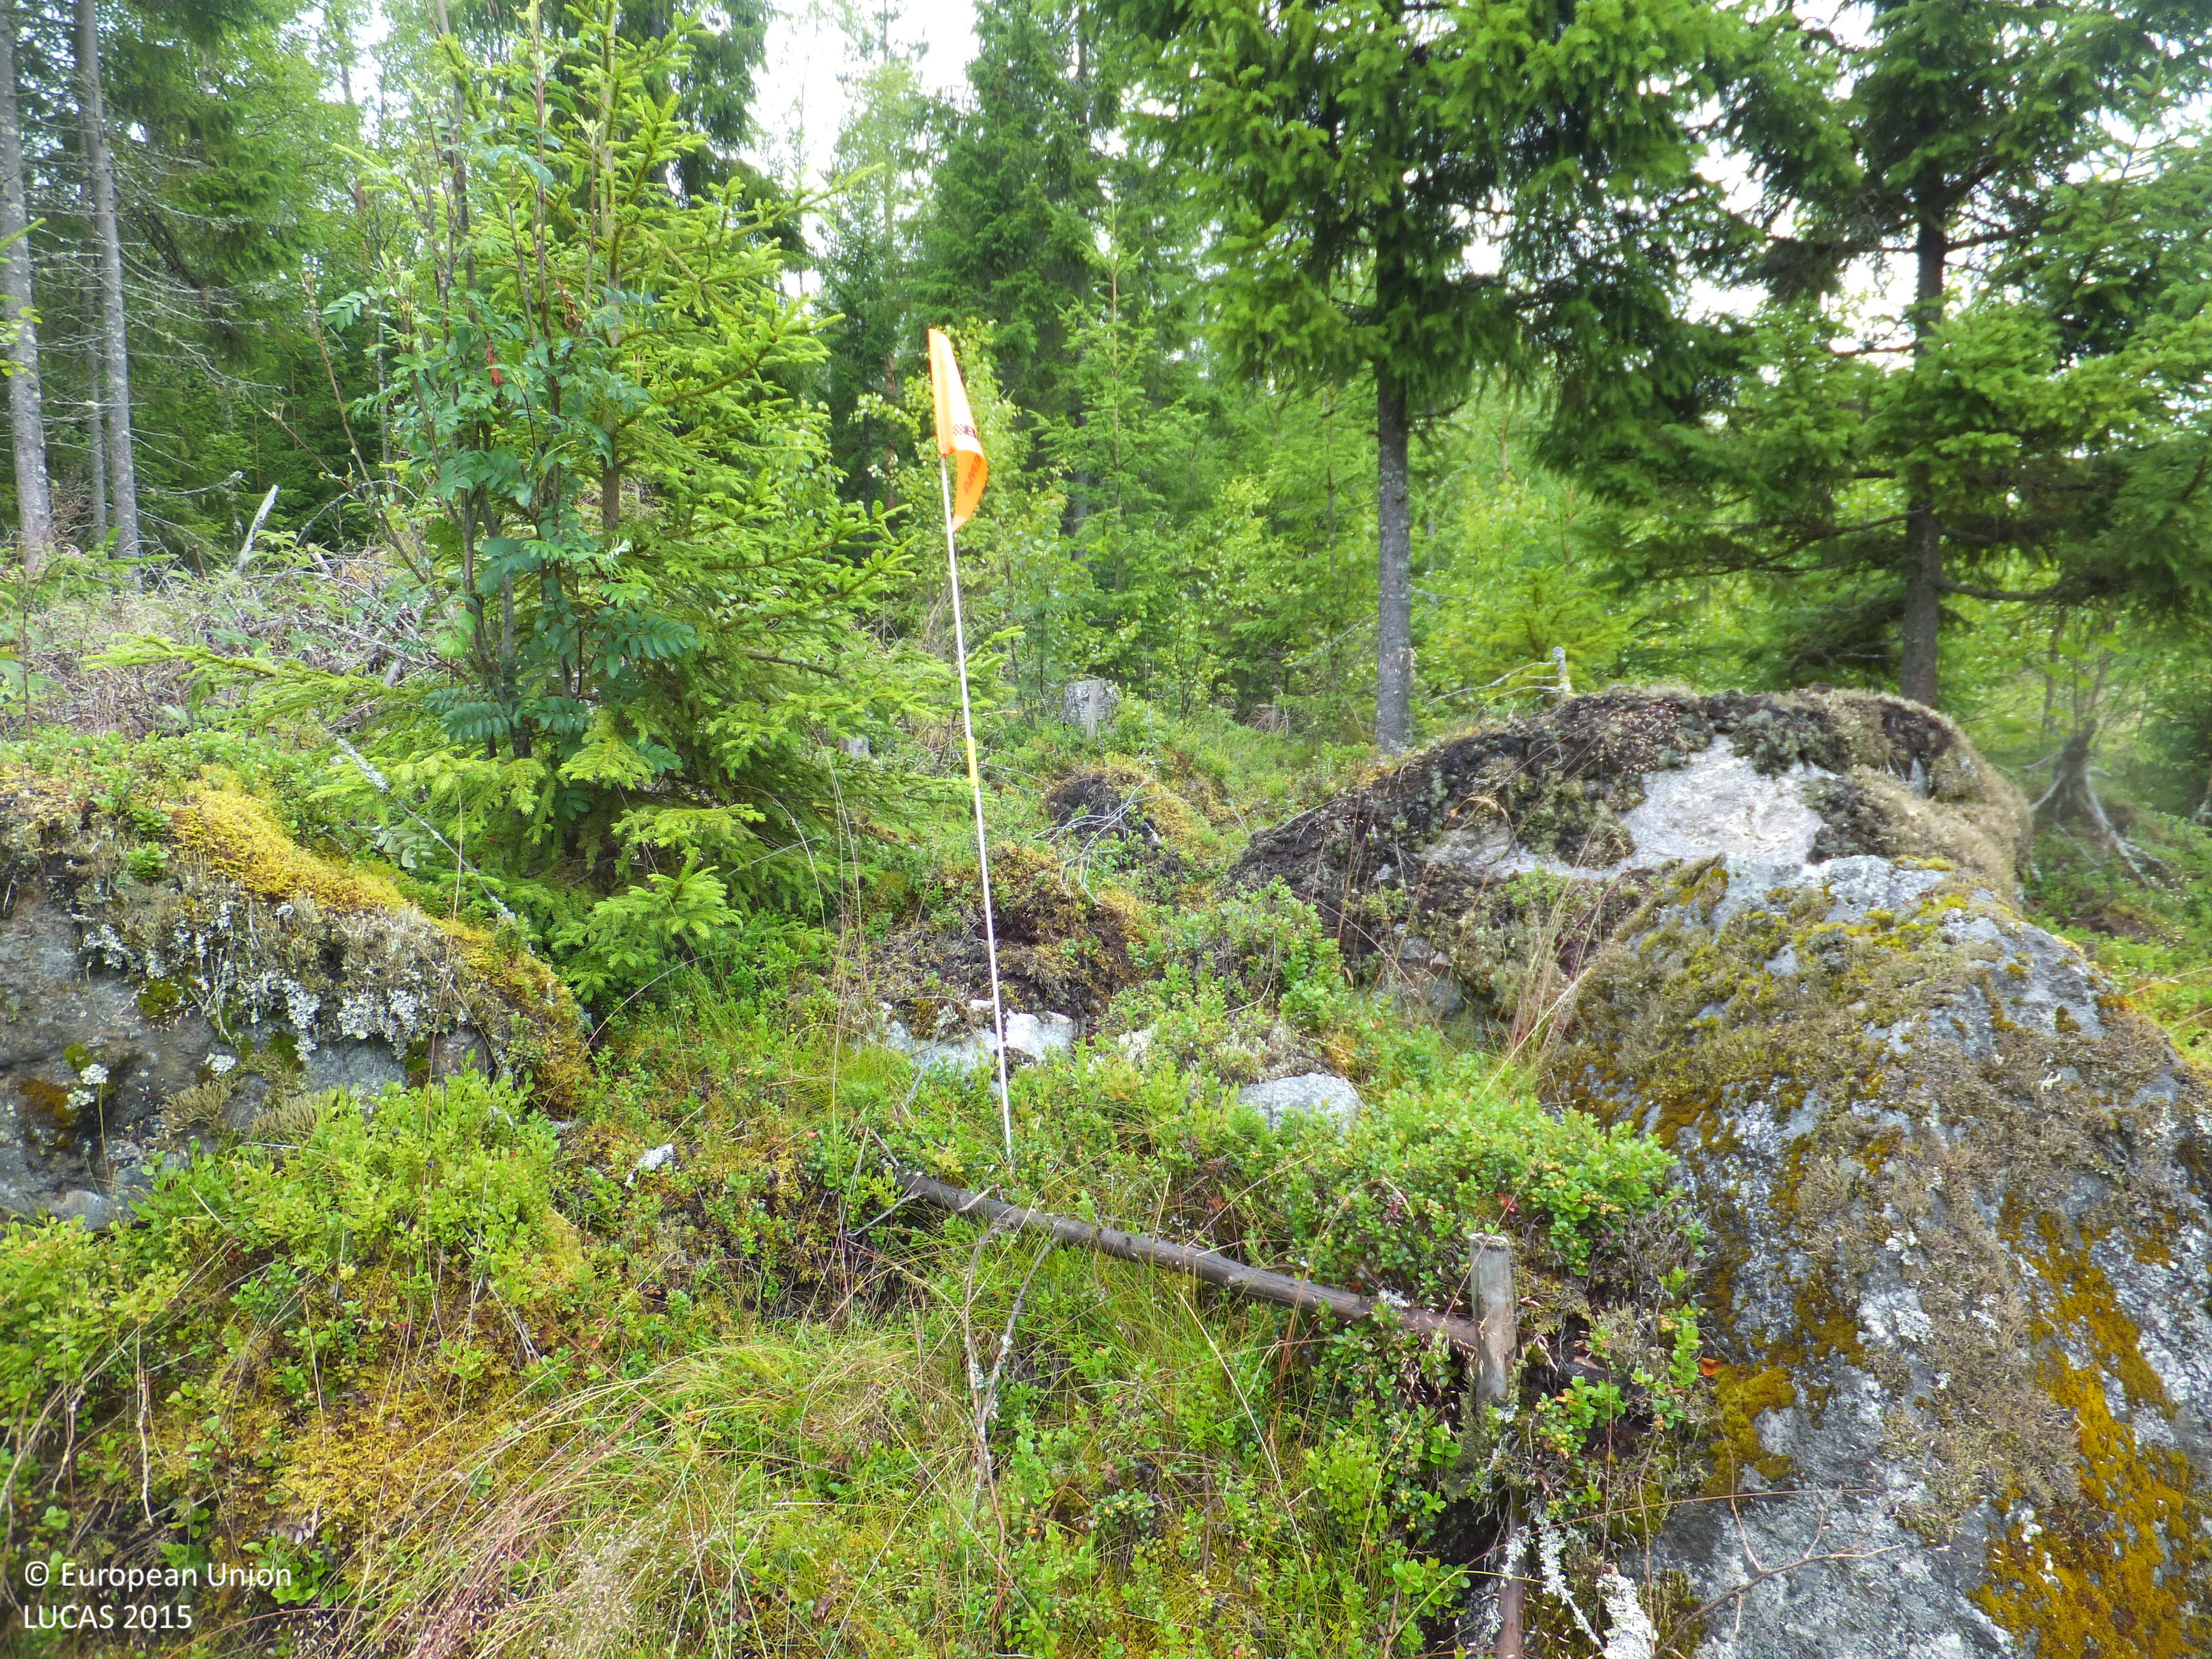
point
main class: Woodland
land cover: Spruce dominated mixed woodland
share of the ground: 10 - 25 %
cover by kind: shrubs 30 %, herbaceous plants 20 %, lichens and mosses 20 %, coniferous forest trees 10 %, broadleaved forest trees 10 %, consolidated bare surface 10 %
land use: Forestry
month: July
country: FI
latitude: 63.0324
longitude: 21.9231
